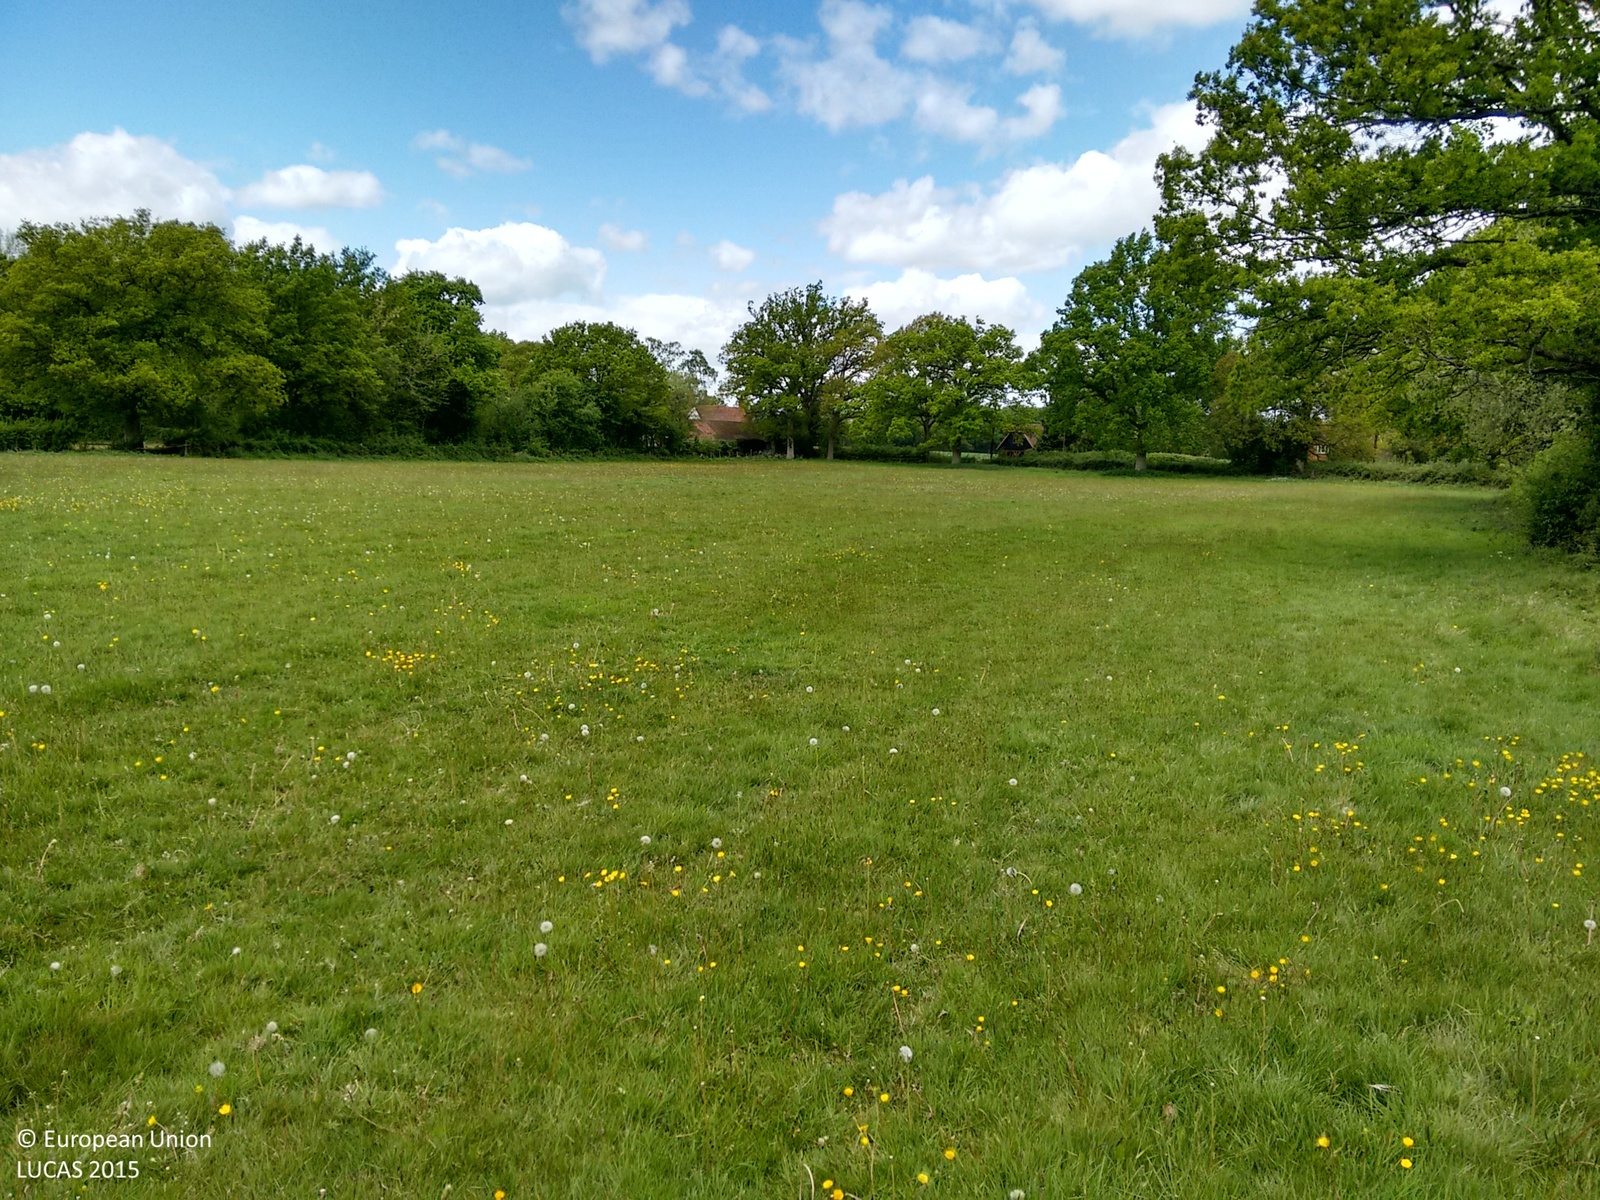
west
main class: Grassland
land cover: Grassland without tree/shrub cover
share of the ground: > 75 %
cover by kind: herbaceous plants 100 %
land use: Agriculture (excluding fallow land and kitchen gardens)
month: May
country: GB
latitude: 51.3399
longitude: -1.1719
